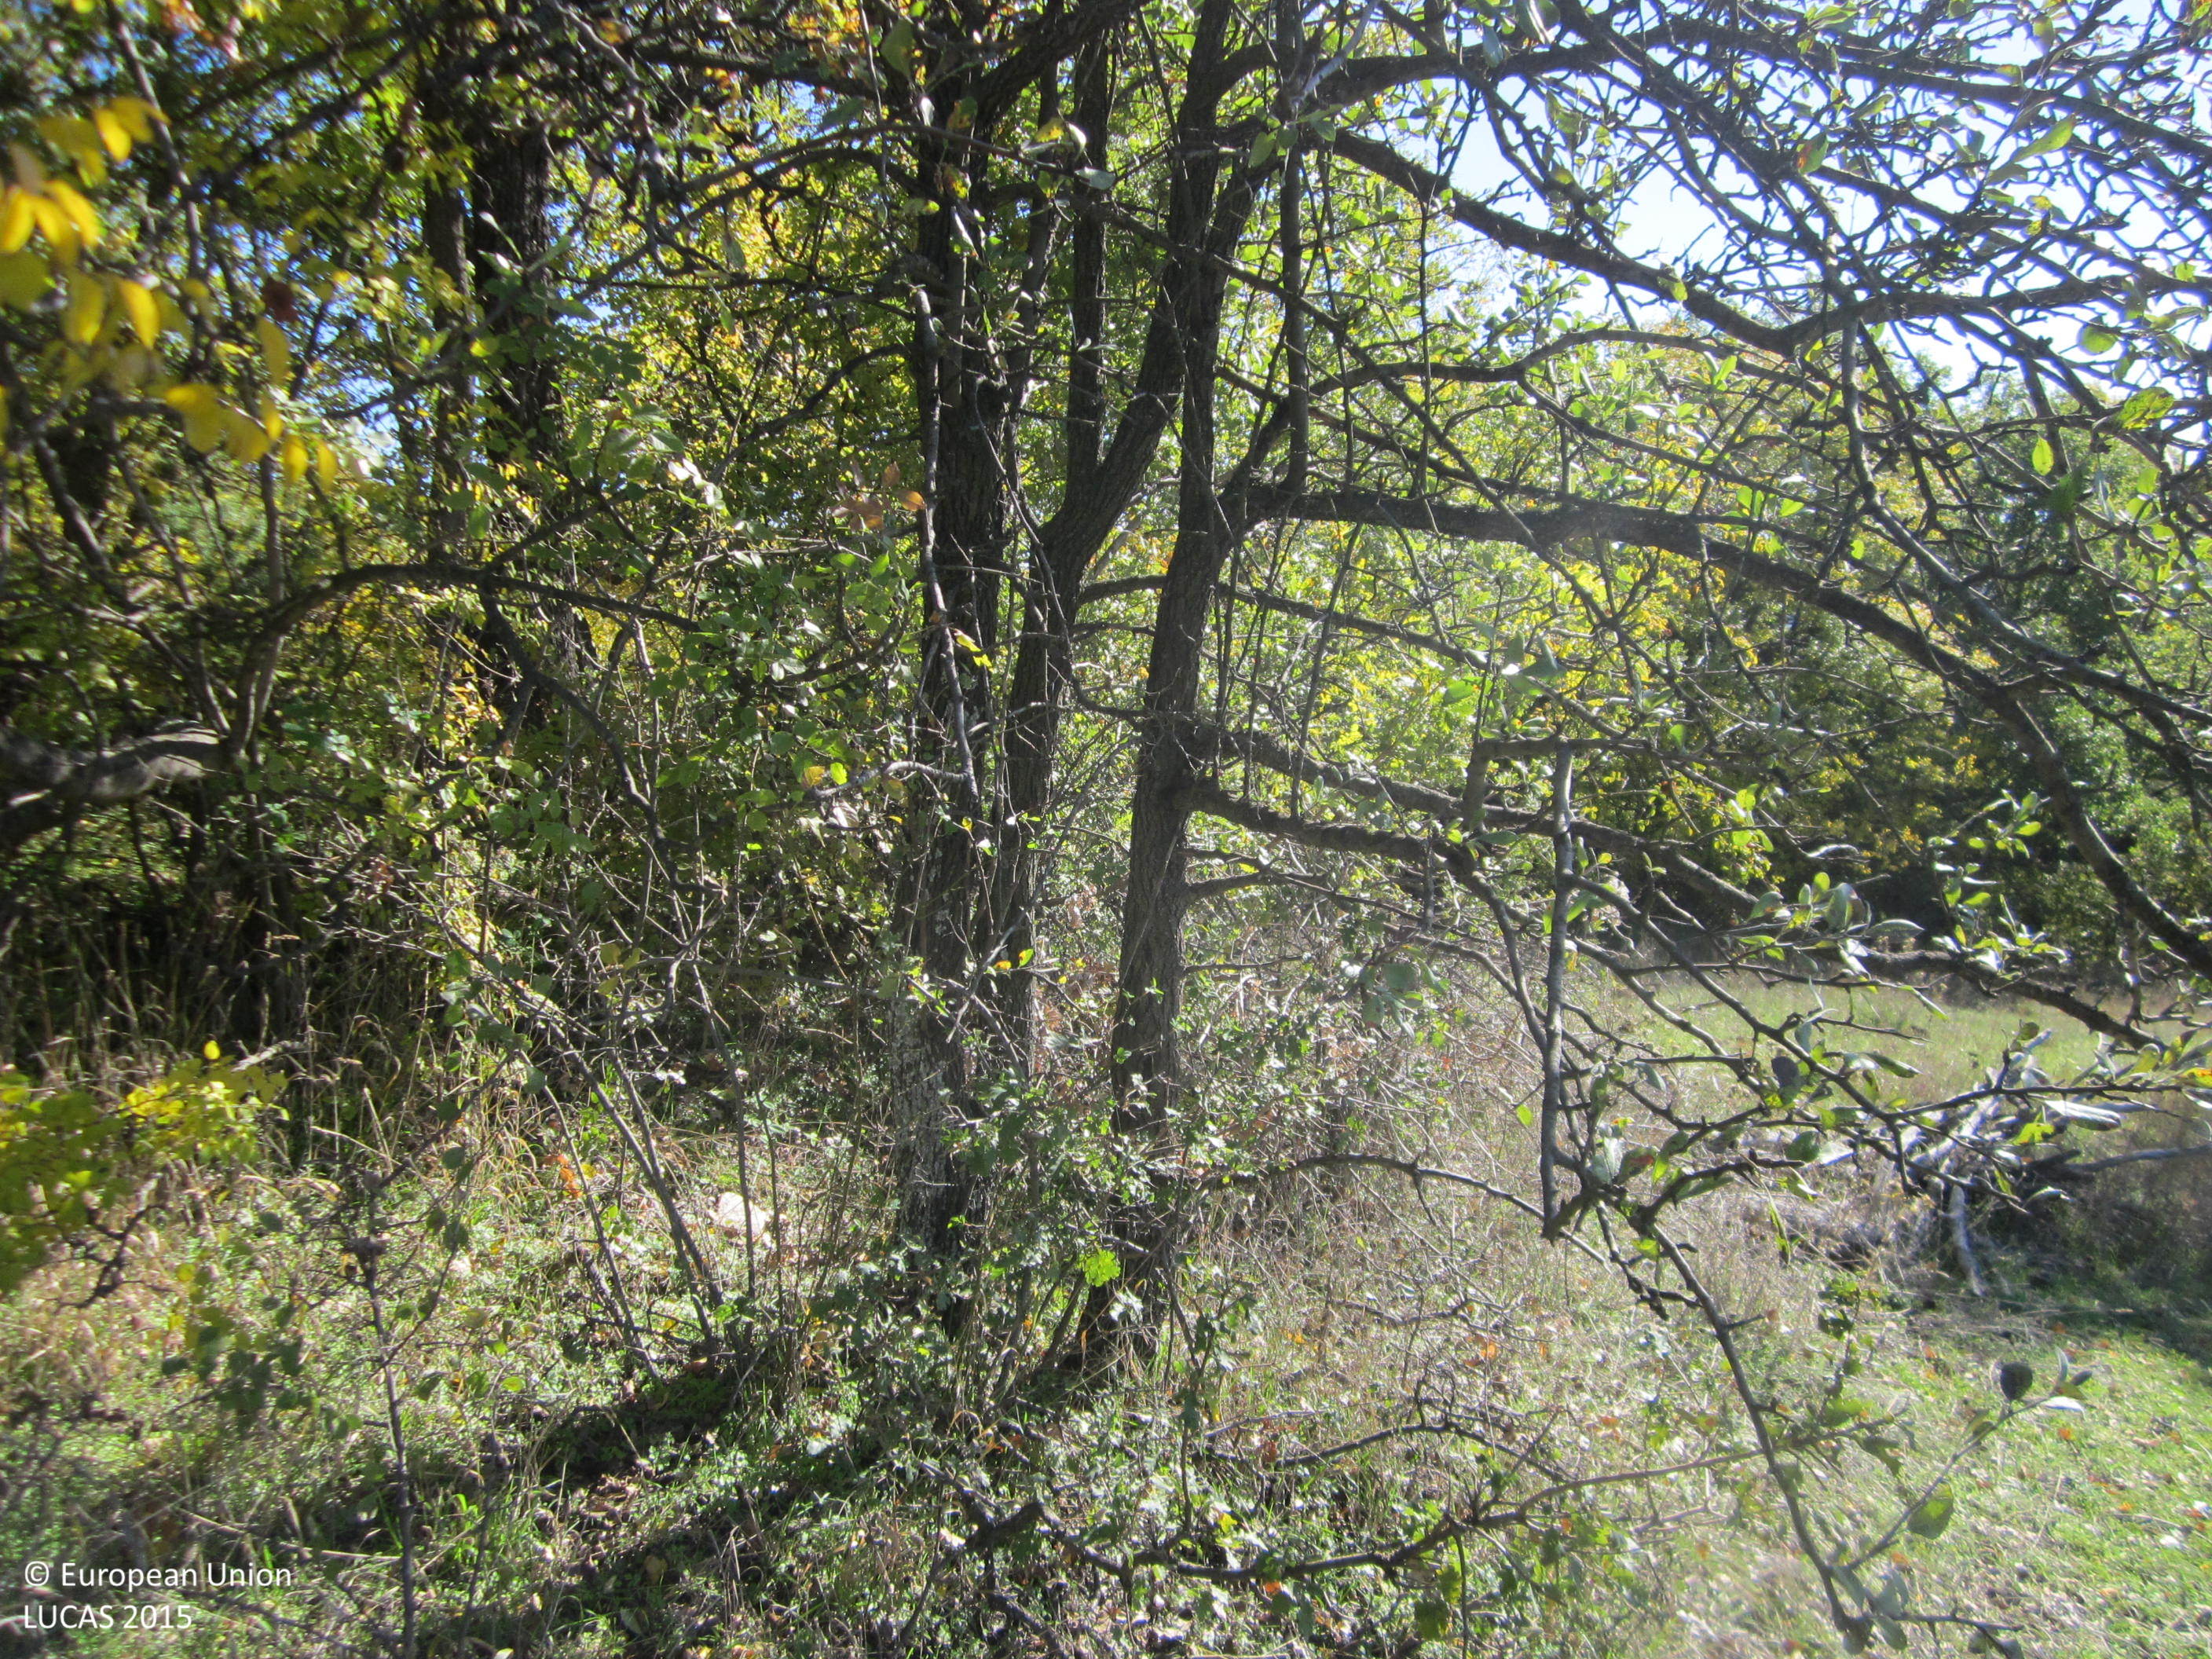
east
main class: Woodland
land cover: Broadleaved woodland
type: hemiboreal forest and nemoral coniferous forest and mixed broadleaved-coniferous forest
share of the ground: > 75 %
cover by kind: broadleaved forest trees 100 %
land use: Forestry
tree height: > 5 m
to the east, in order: Broadleaved woodland
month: November
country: BG
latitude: 41.4337
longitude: 25.8485
